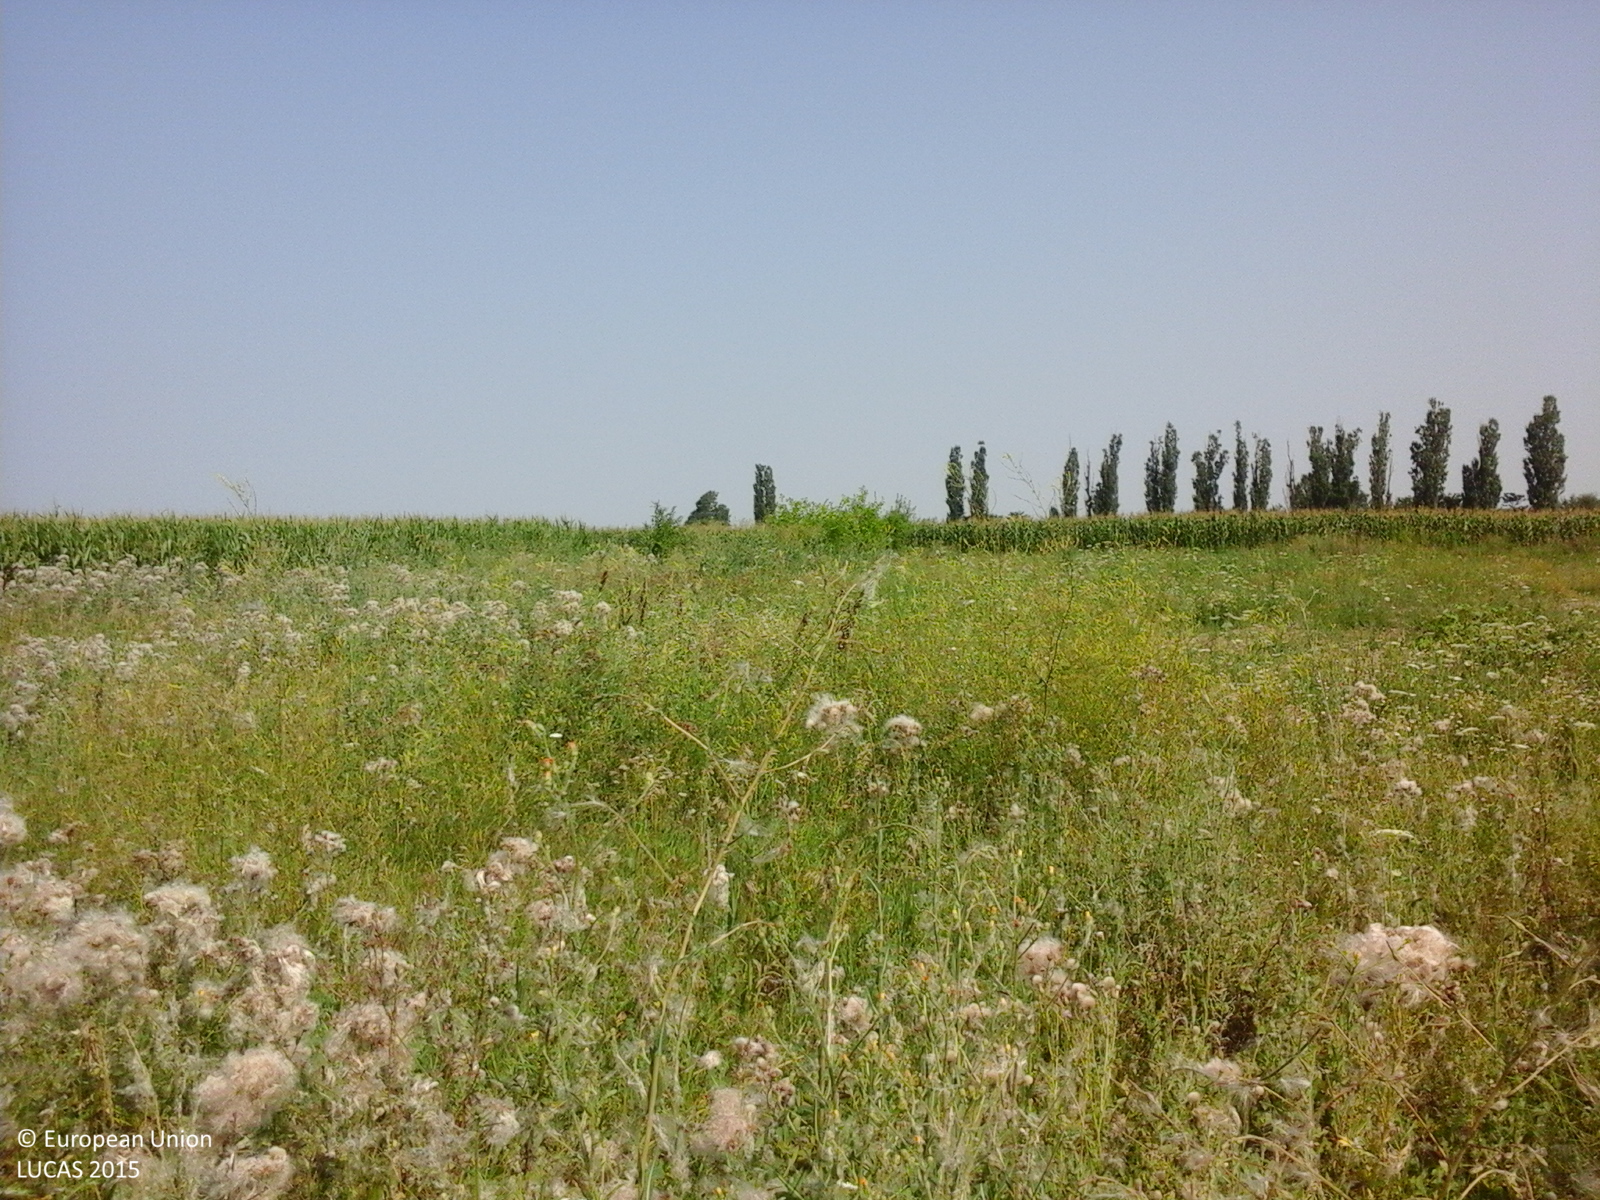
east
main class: Cropland
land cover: Maize
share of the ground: > 75 %
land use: Agriculture (excluding fallow land and kitchen gardens)
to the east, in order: Maize; Spontaneously vegetated surfaces; Maize; Grass margins; Ditches and canals; Grass margins; Tracks; Grass margins; Maize
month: July
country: RO
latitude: 44.8168
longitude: 26.8586
